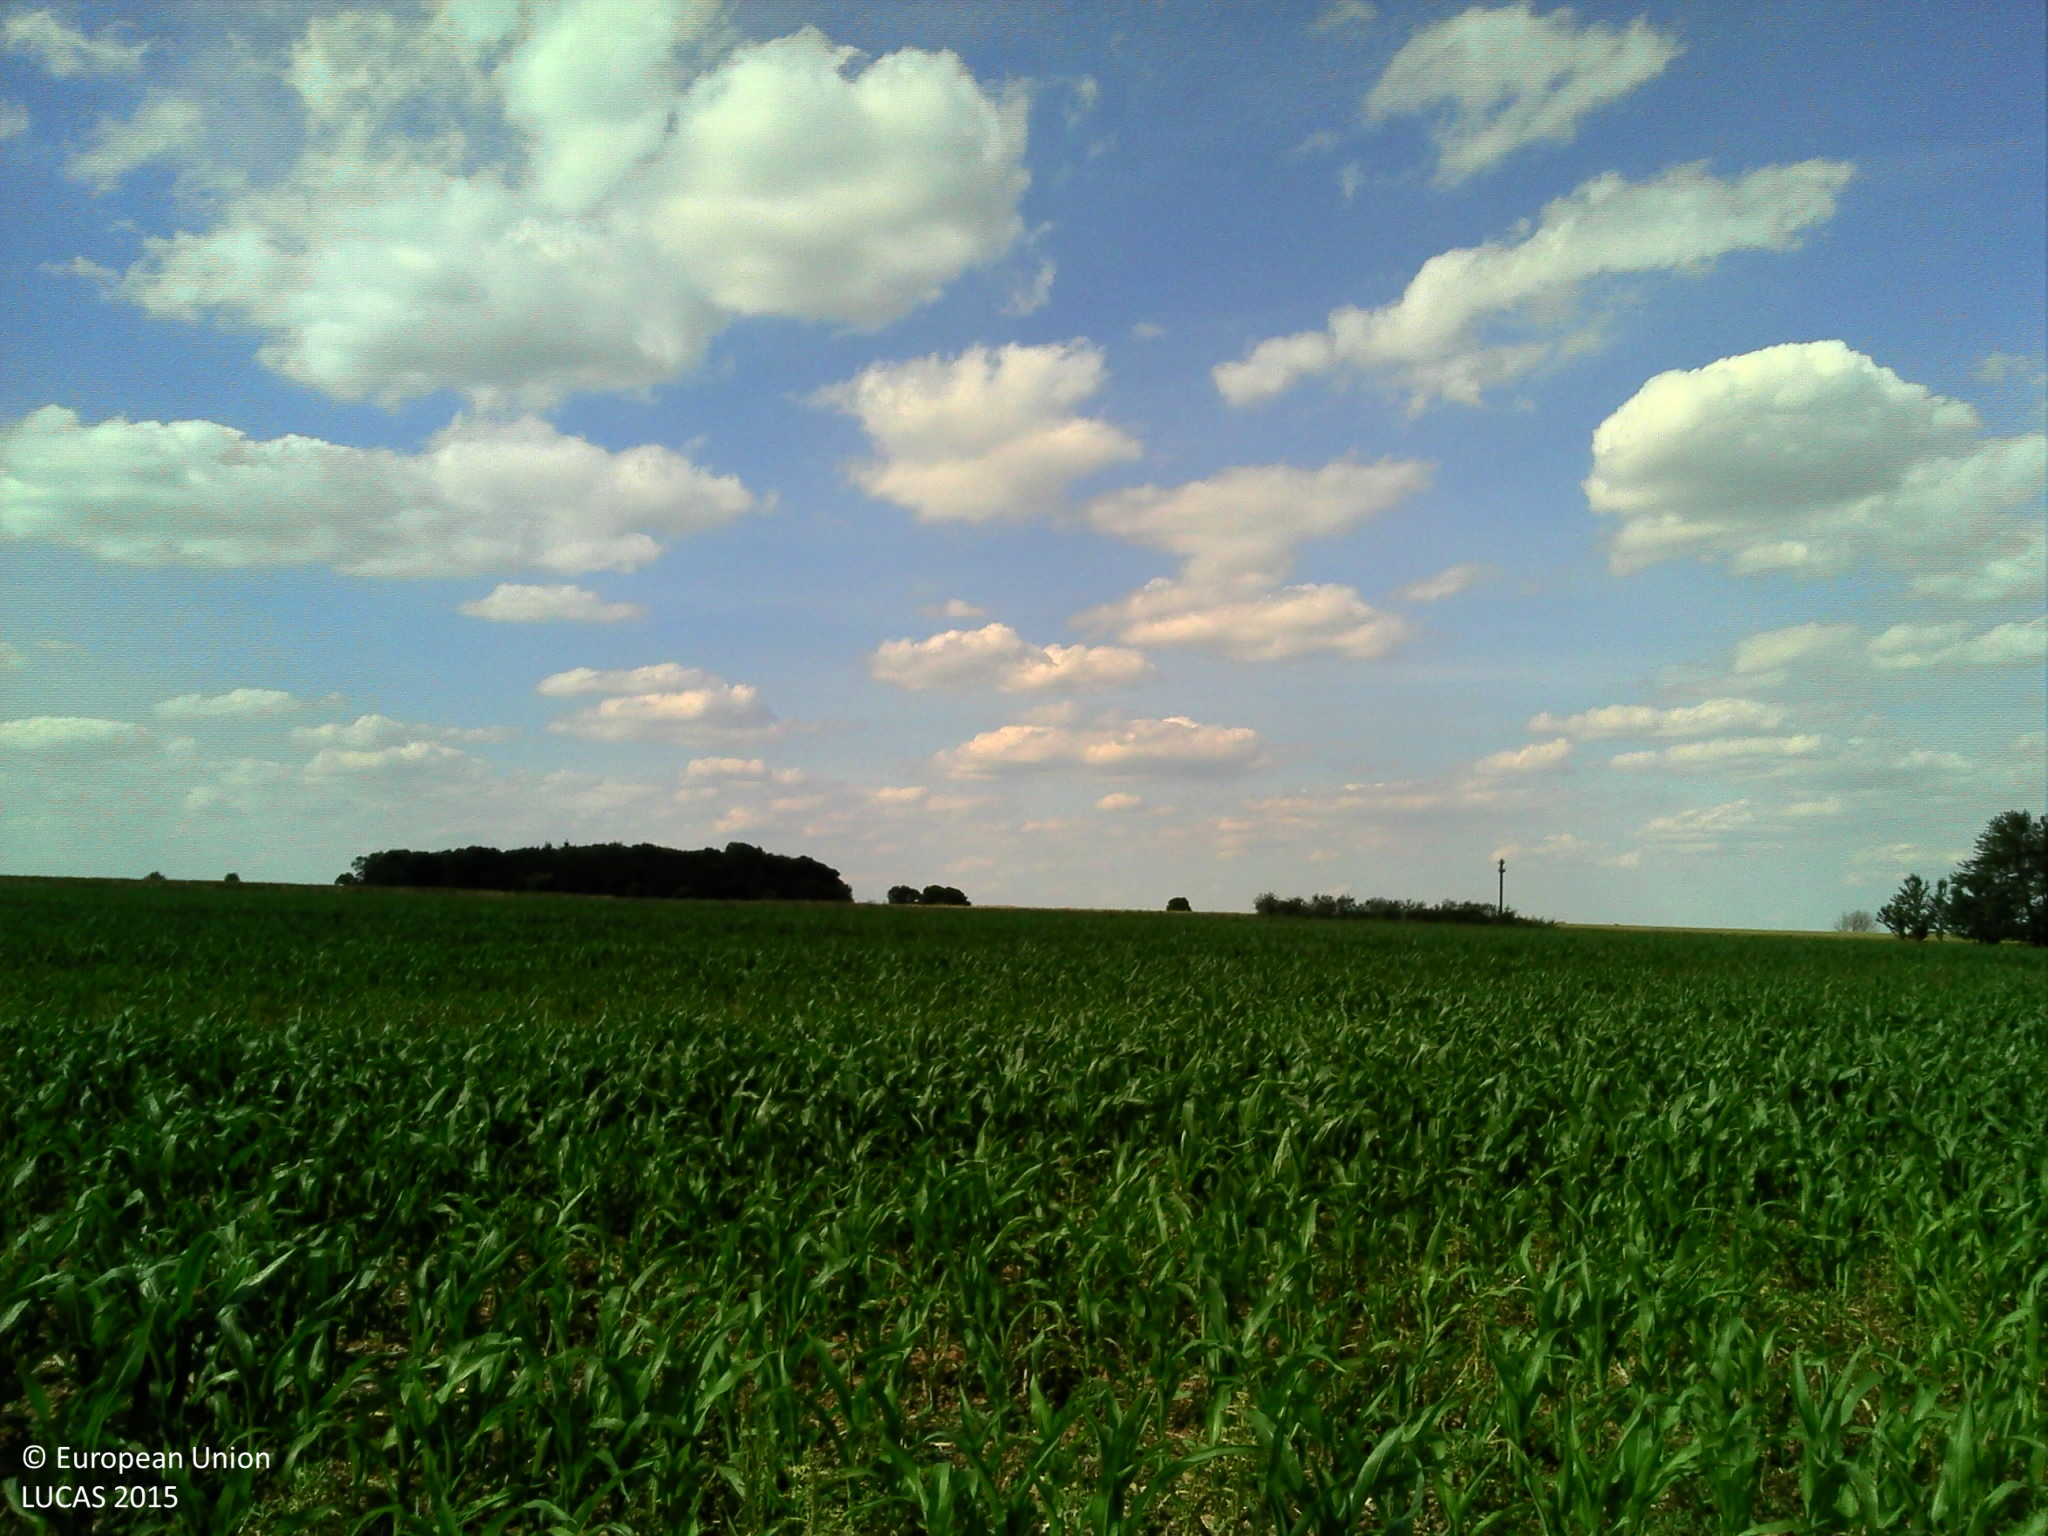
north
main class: Cropland
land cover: Maize
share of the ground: 50 - 75 %
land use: Agriculture (excluding fallow land and kitchen gardens)
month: June
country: FR
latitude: 49.3814
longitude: 2.5639
